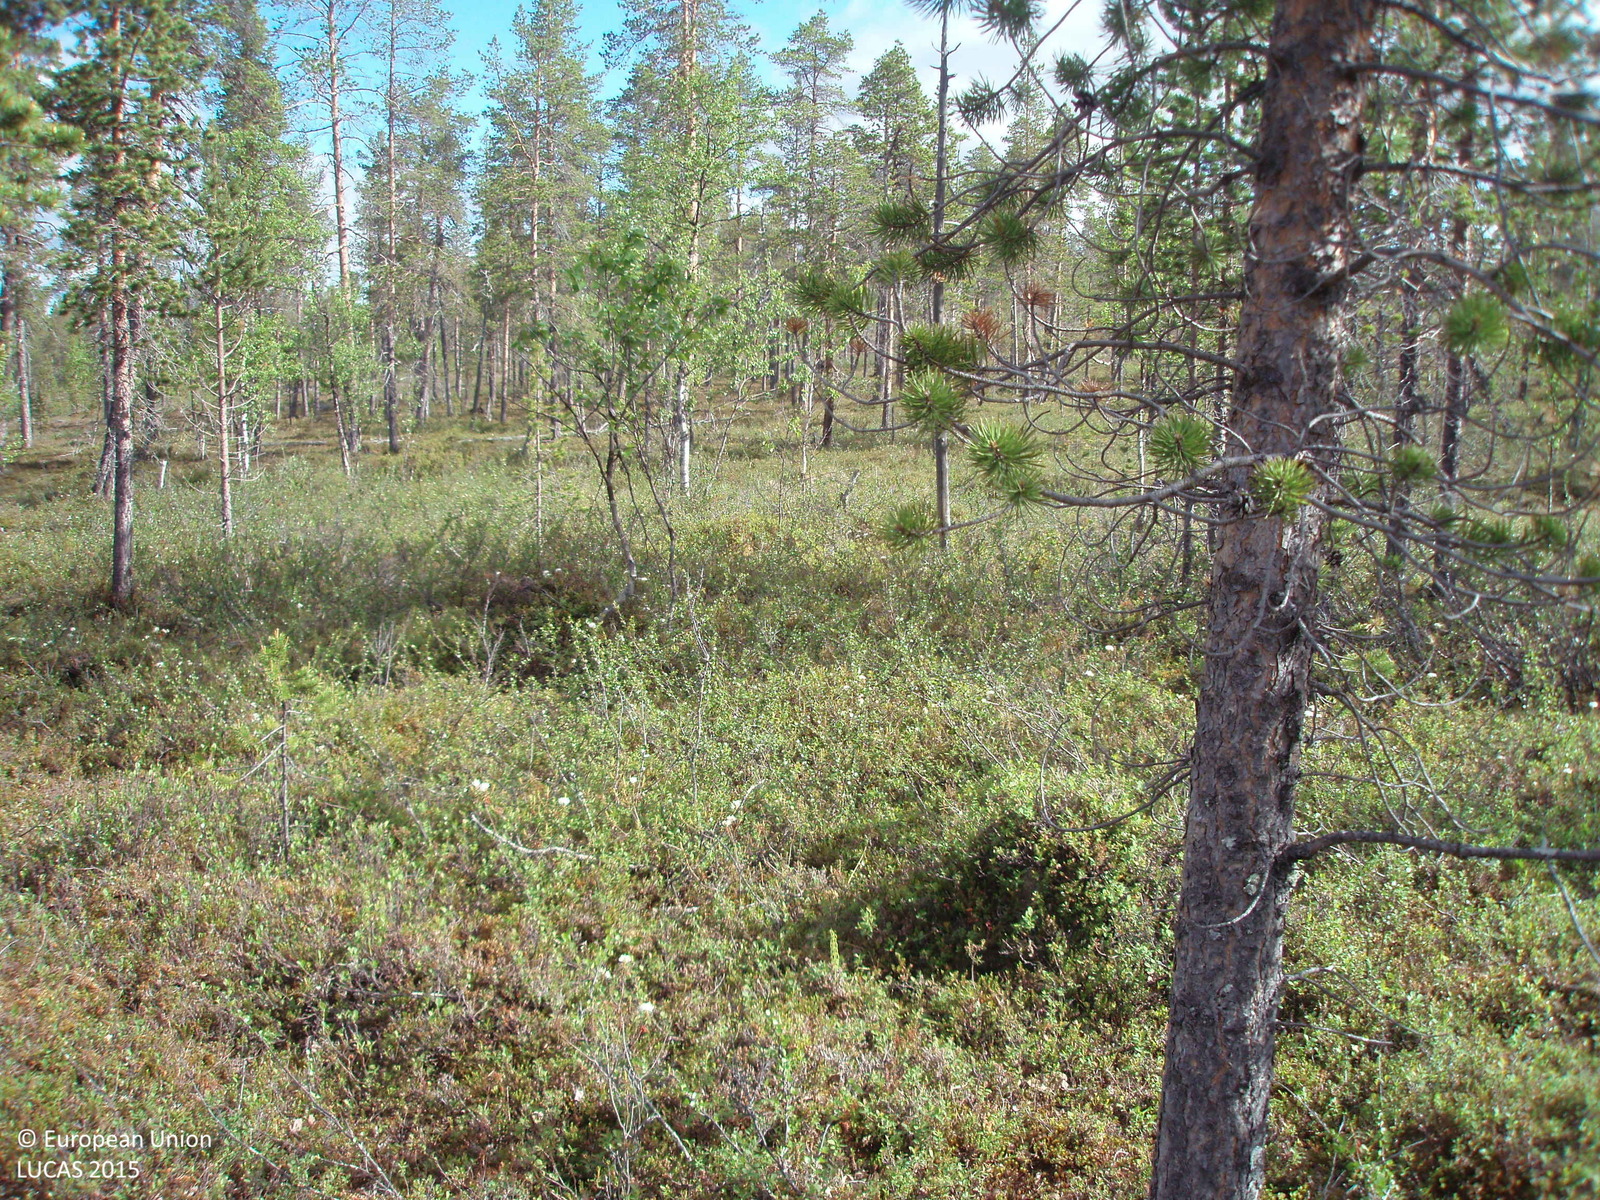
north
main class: Woodland
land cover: Pine dominated mixed woodland
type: boreal forest
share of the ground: 25 - 50 %
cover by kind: shrubs 50 %, broadleaved forest trees 25 %, coniferous forest trees 20 %, lichens and mosses 5 %
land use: Forestry
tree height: > 5 m
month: June
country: FI
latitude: 68.6567
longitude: 26.3216
